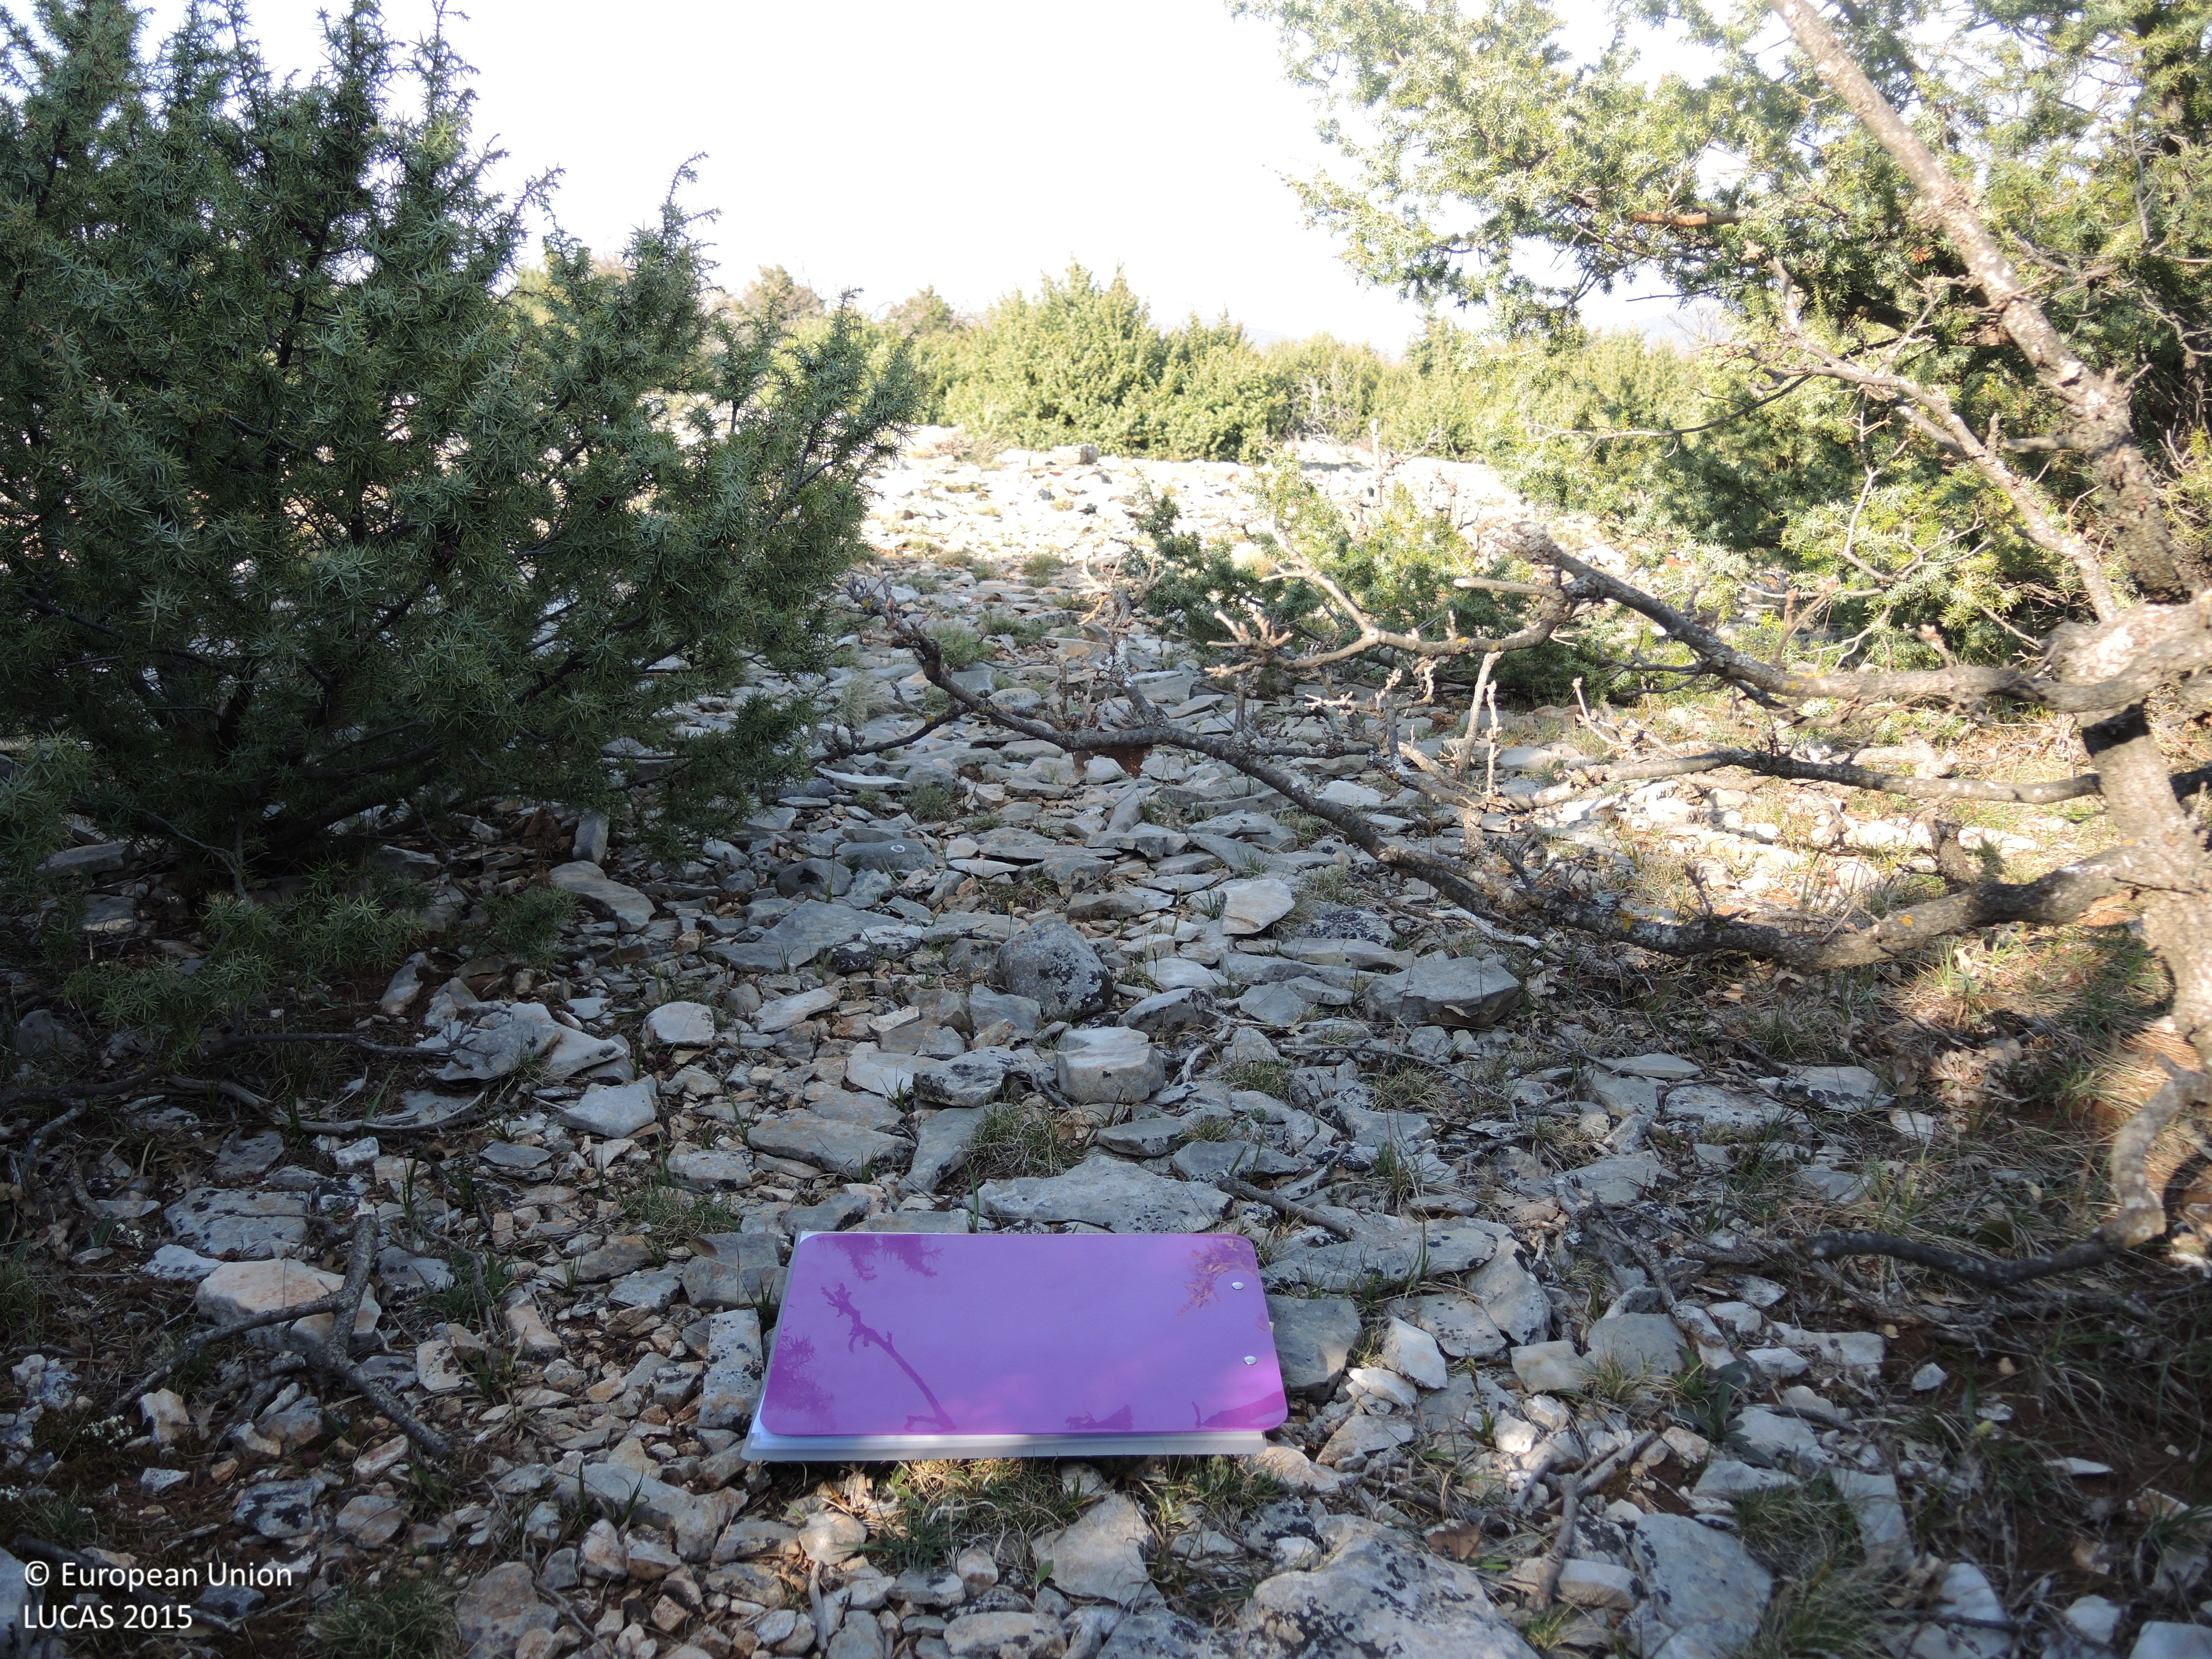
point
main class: Shrubland
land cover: Shrubland with sparse tree cover
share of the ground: 25 - 50 %
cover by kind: unconsolidated bare surface 35 %, shrubs 30 %, herbaceous plants 20 %, consolidated bare surface 10 %, broadleaved forest trees 5 %
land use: Semi-natural and natural areas not in use
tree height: < 5 m
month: April
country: HR
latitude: 44.0495
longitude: 15.6959
